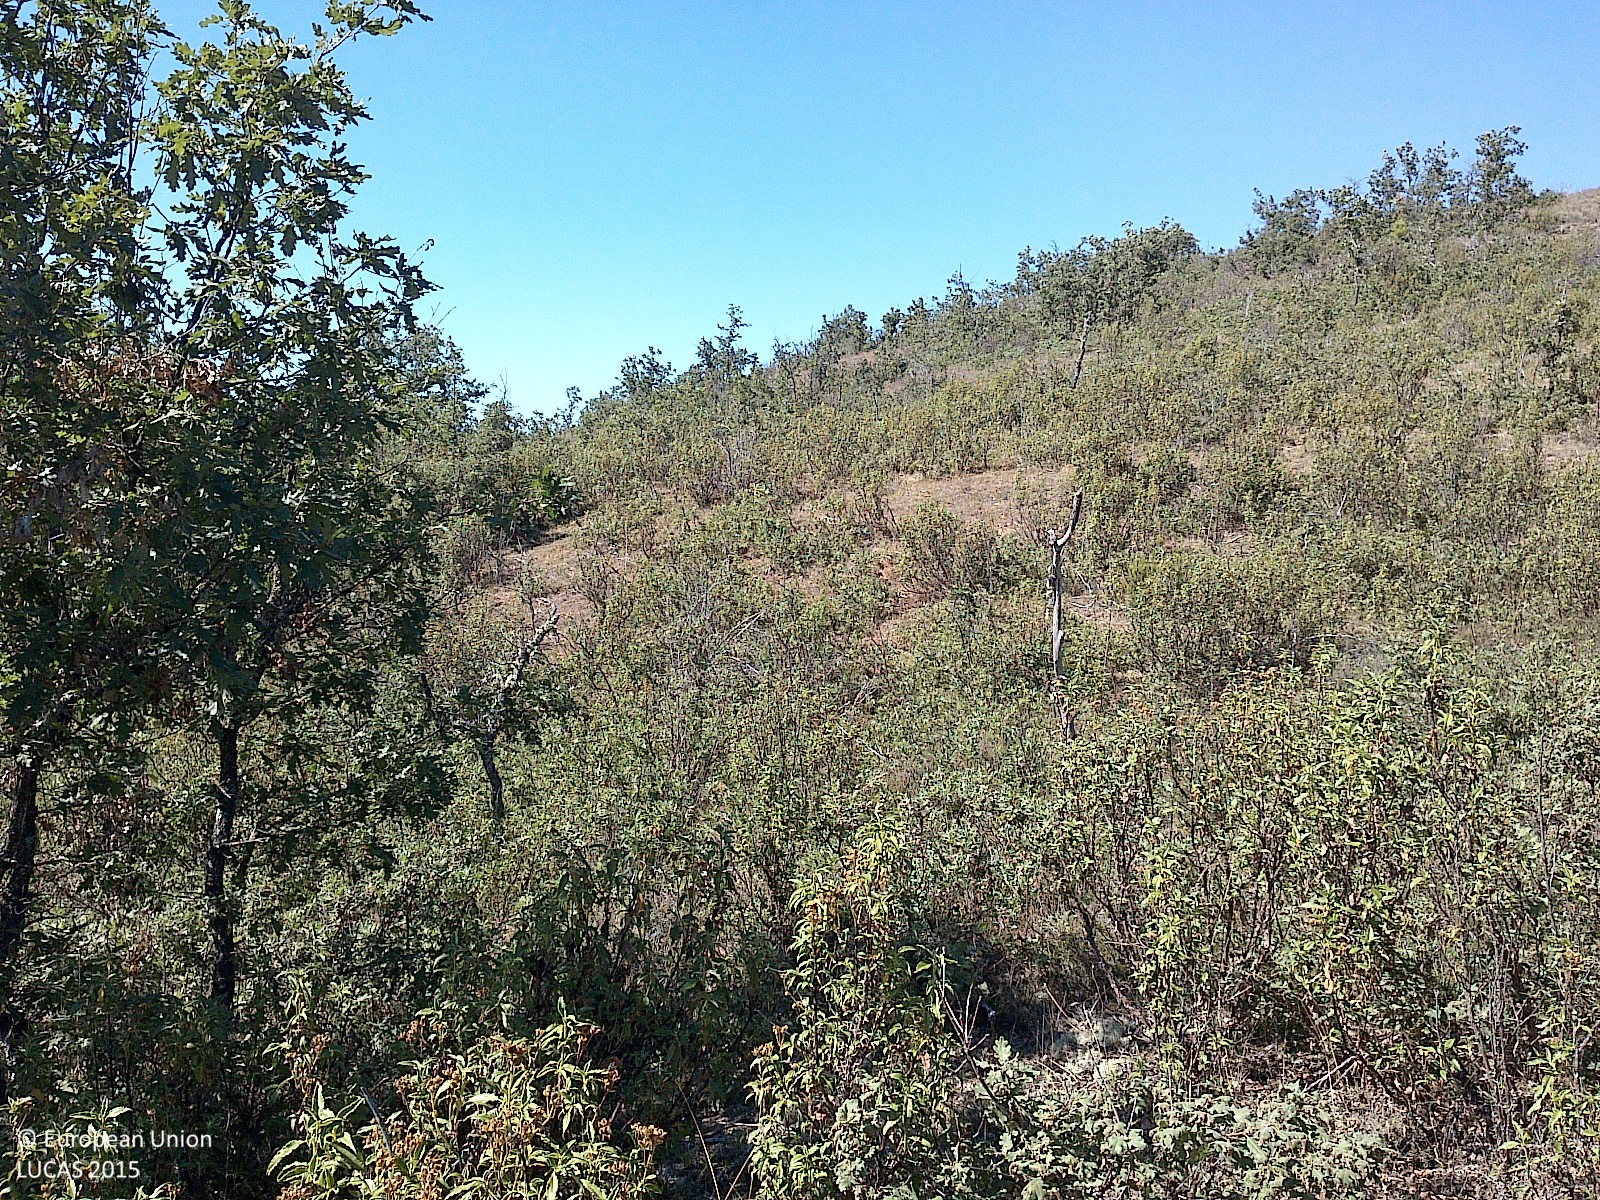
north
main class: Woodland
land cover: Broadleaved woodland
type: thermophilous deciduous forest
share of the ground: 10 - 25 %
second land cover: Grassland without tree/shrub cover
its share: 25 - 50 %
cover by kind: shrubs 55 %, herbaceous plants 25 %, broadleaved forest trees 20 %
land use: Forestry
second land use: Agriculture (excluding fallow land and kitchen gardens)
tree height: < 5 m
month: July
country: ES
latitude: 41.9218
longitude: -3.2775
